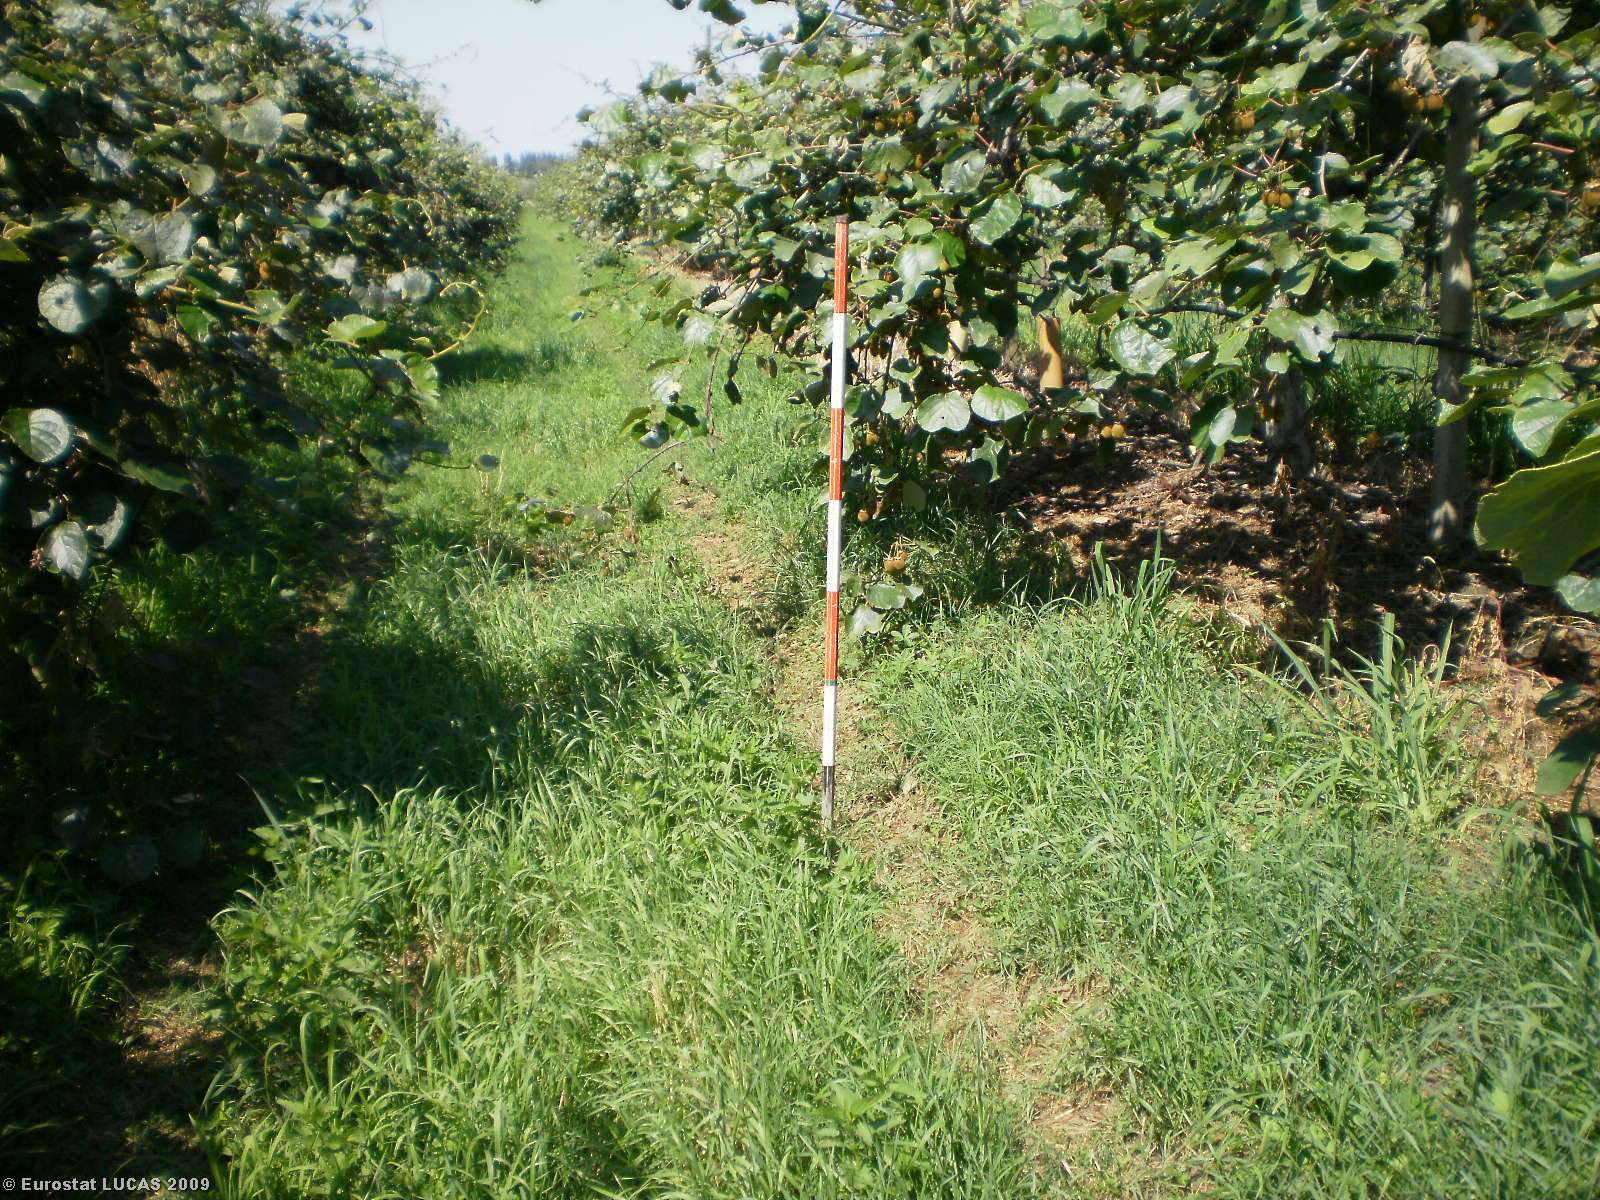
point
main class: Cropland
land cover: Other fruit trees and berries
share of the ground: > 75 %
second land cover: Grassland with sparse tree/shrub cover
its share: > 75 %
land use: Agriculture (excluding fallow land and kitchen gardens)
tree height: < 5 m
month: June
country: IT
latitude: 44.9992
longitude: 10.3418
